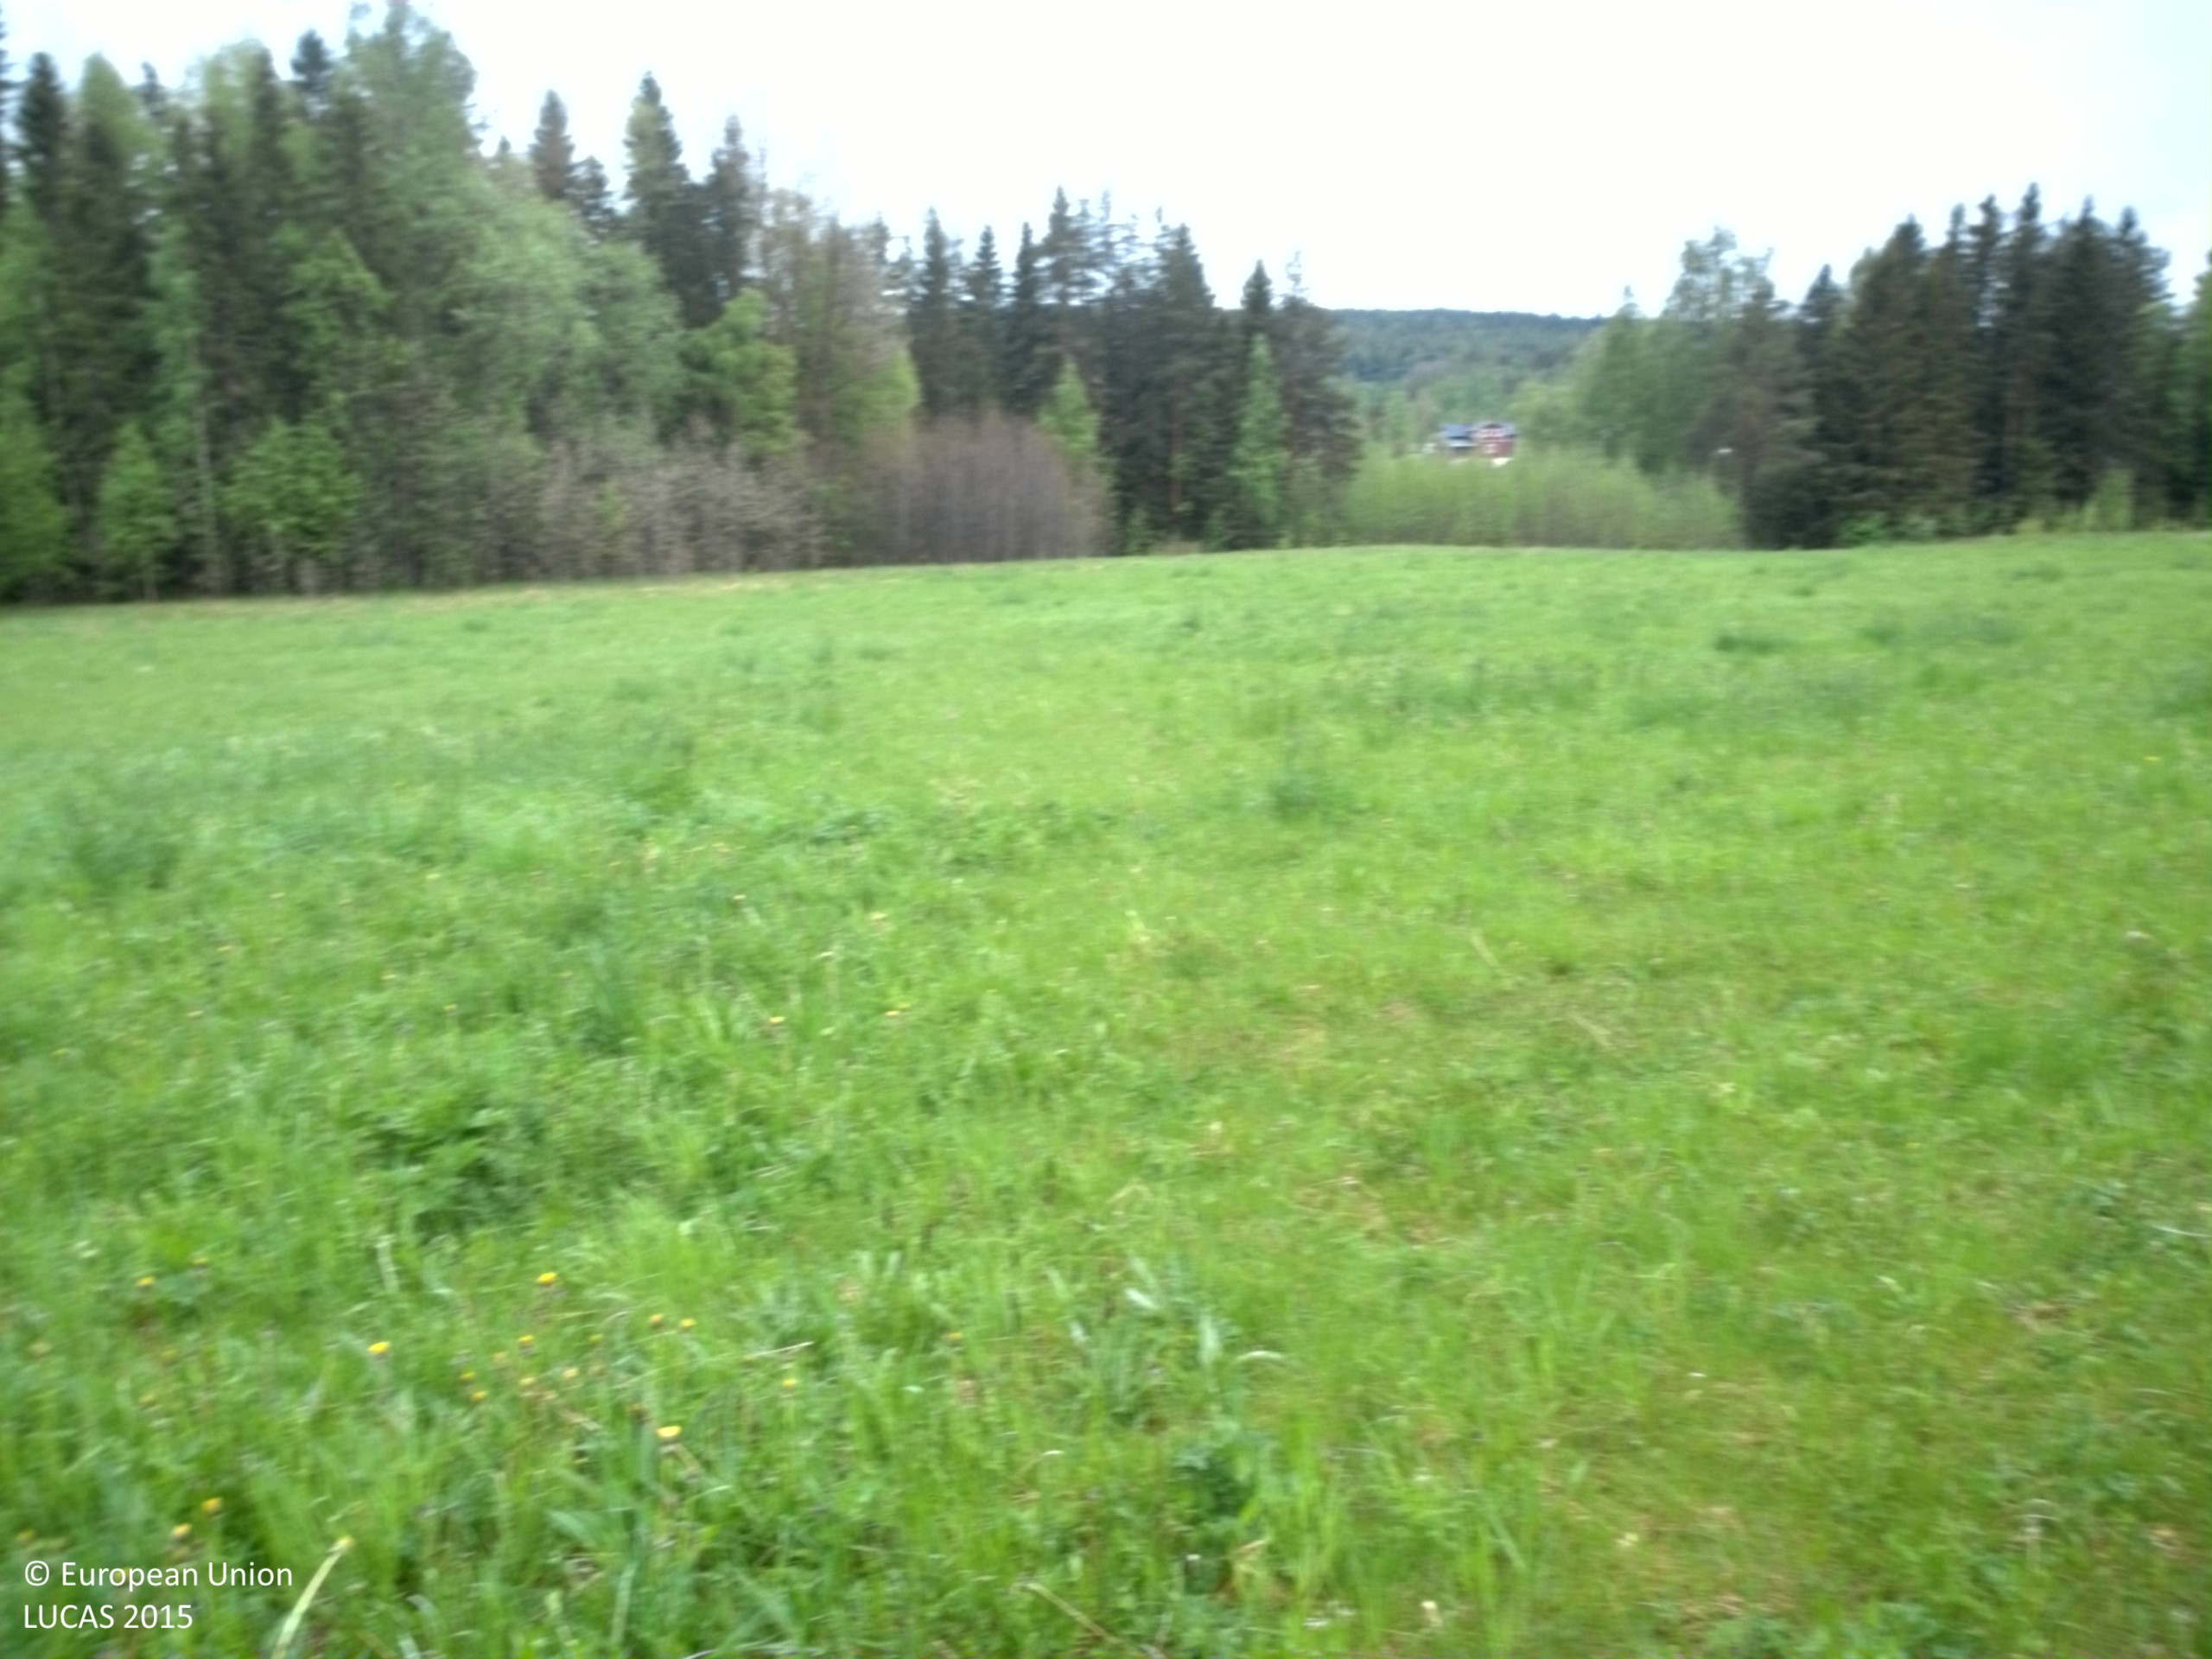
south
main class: Grassland
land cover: Spontaneously vegetated surfaces
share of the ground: > 75 %
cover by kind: herbaceous plants 100 %
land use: Agriculture (excluding fallow land and kitchen gardens)
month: June
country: SE
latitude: 63.1568
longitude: 16.9828
